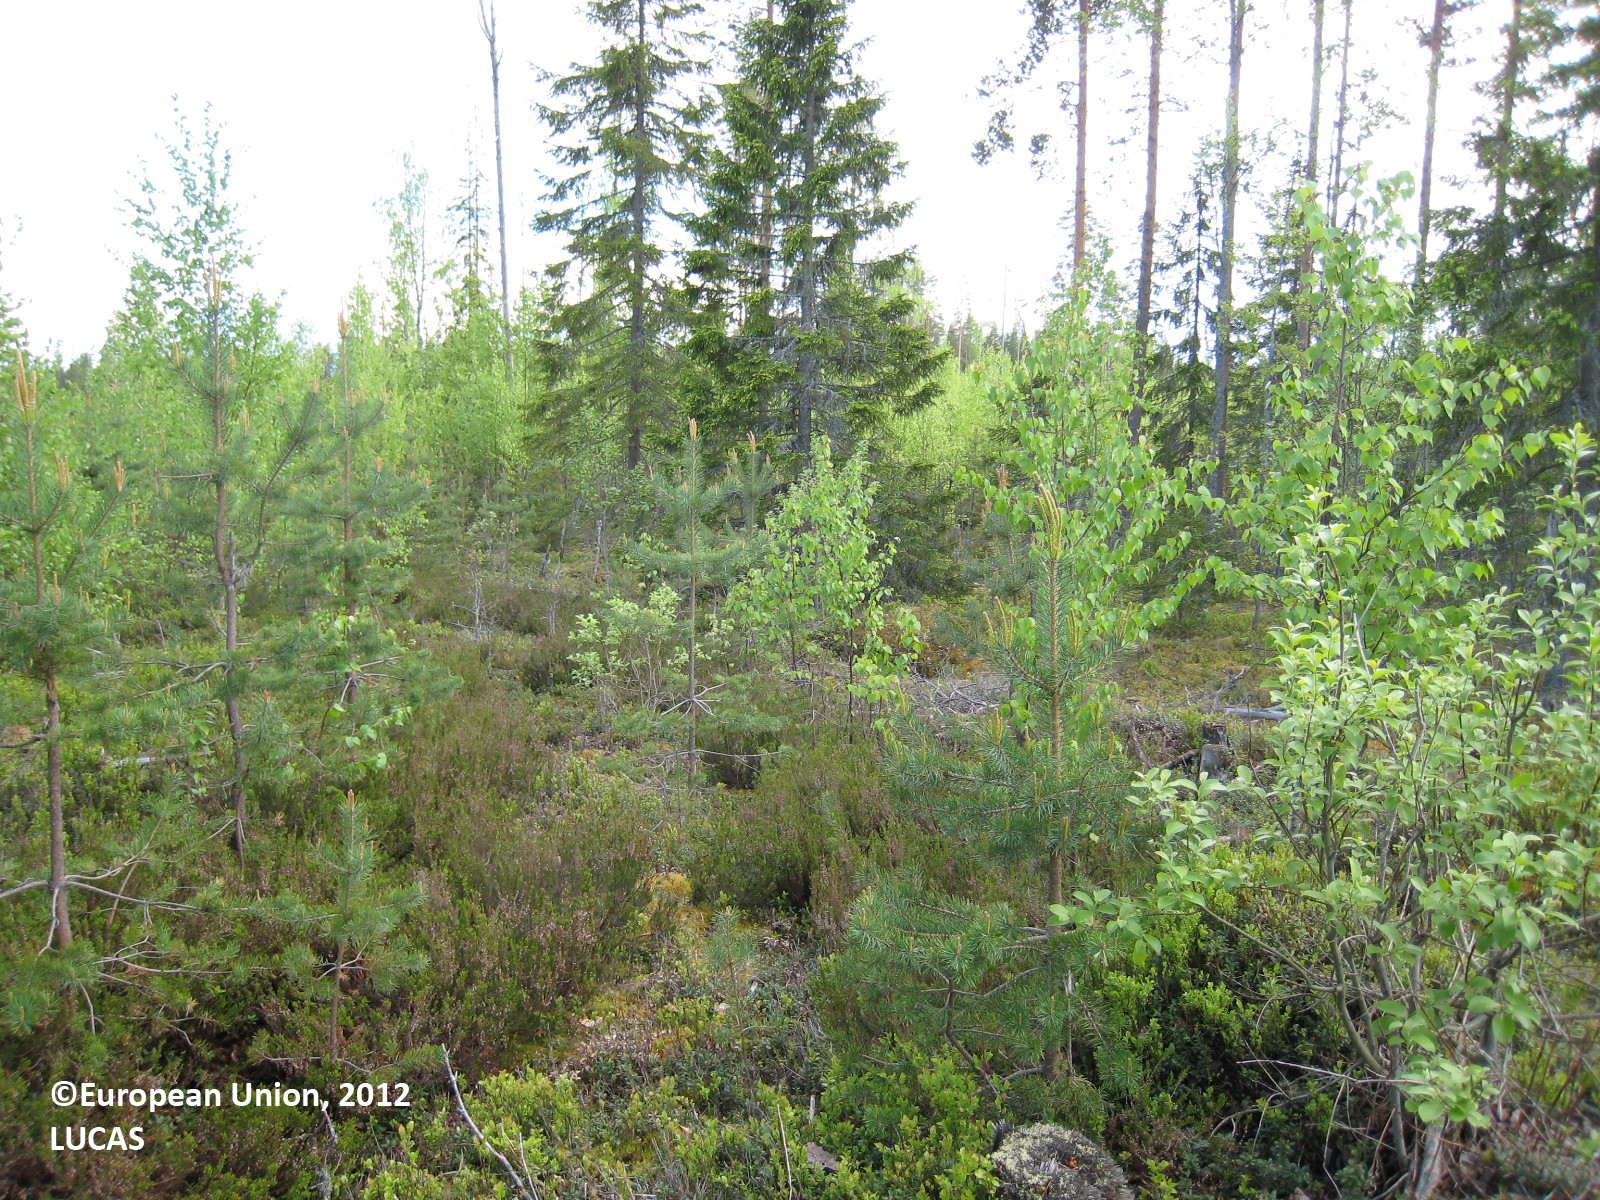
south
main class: Woodland
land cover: Pine dominated mixed woodland
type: boreal forest
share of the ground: 50 - 75 %
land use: Forestry
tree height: < 5 m
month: June
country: FI
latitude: 62.7086
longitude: 25.6550
